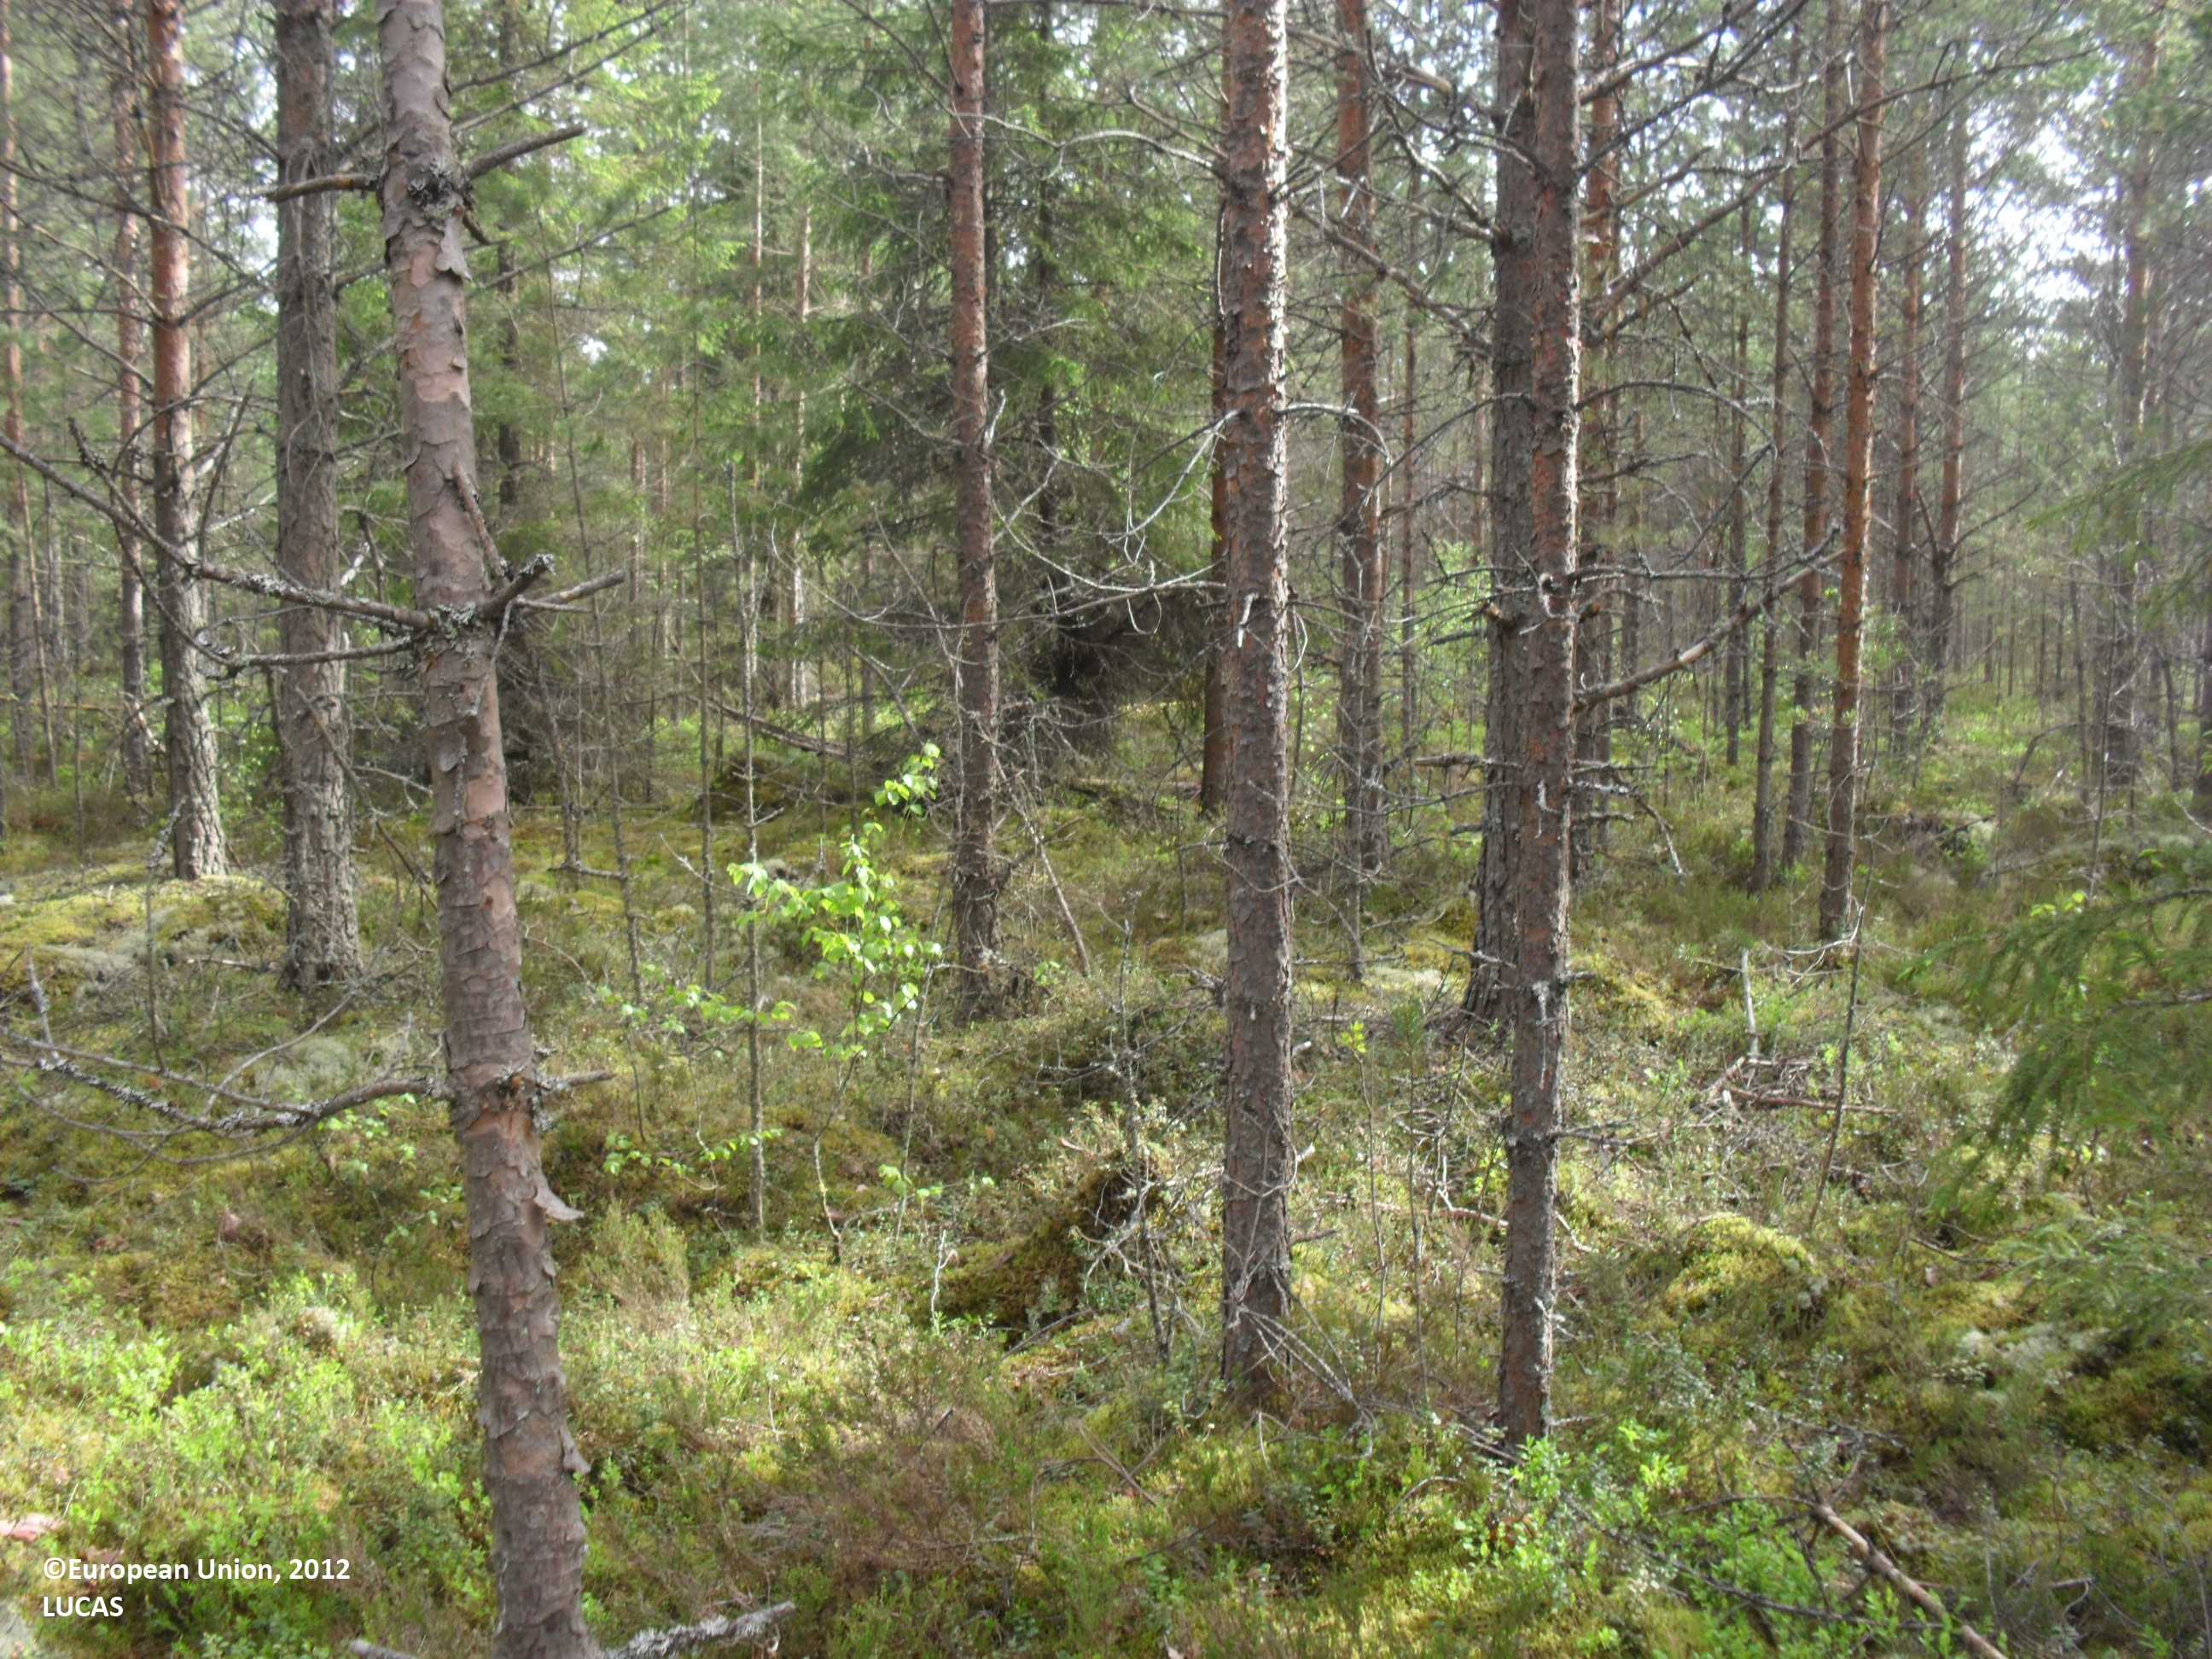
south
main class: Woodland
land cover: Pine dominated coniferous woodland
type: boreal forest
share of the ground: 50 - 75 %
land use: Forestry
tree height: > 5 m
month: June
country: FI
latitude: 62.7894
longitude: 23.2970
